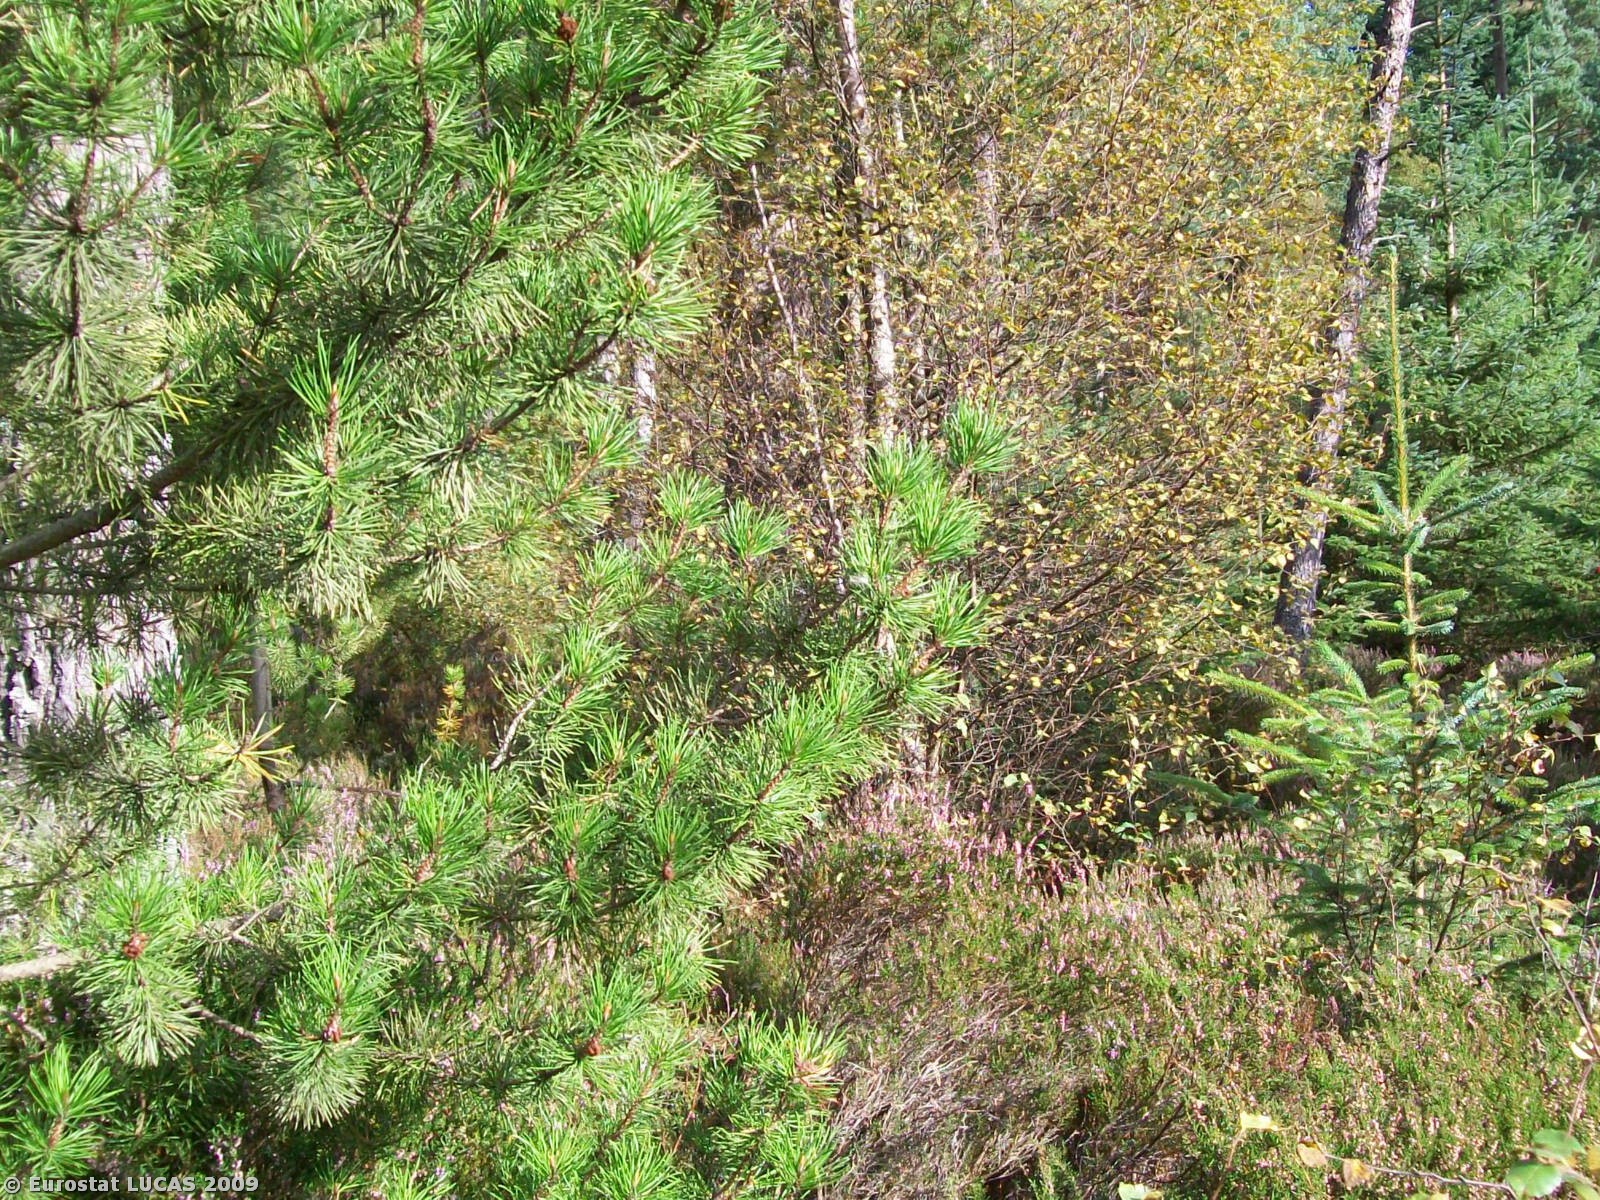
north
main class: Woodland
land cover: Coniferous woodland
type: plantations and self-sown exotic forest
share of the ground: 50 - 75 %
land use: Forestry
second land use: Forestry
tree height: > 5 m
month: September
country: GB
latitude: 57.2854
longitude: -2.5130
